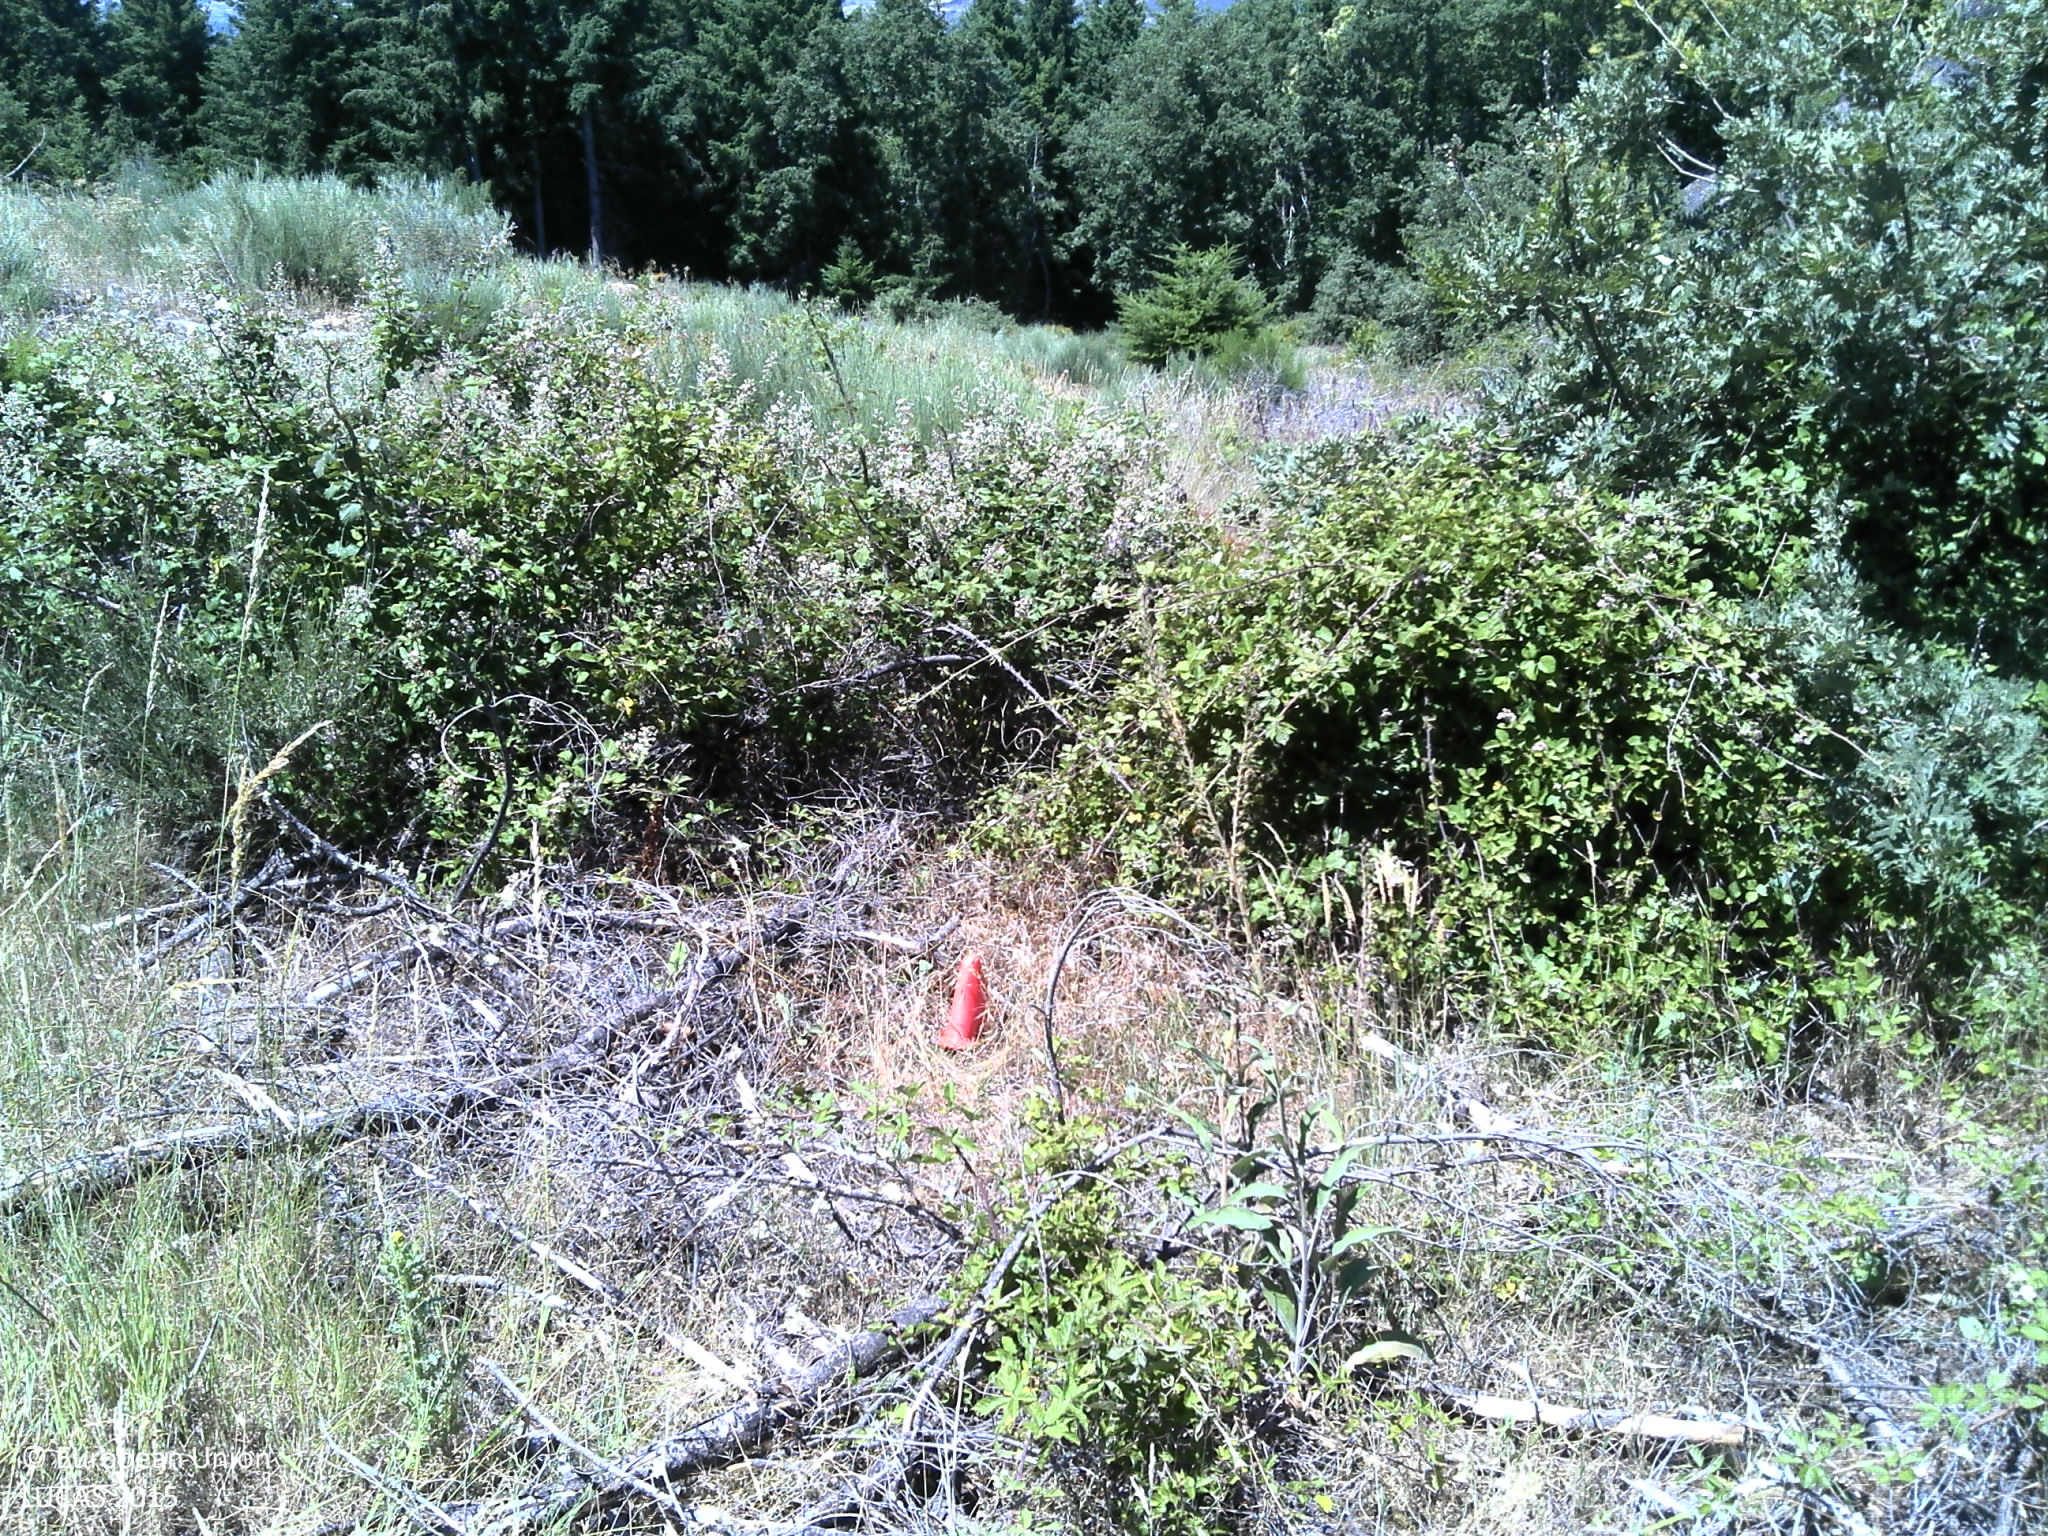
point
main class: Shrubland
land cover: Shrubland with sparse tree cover
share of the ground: > 75 %
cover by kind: shrubs 90 %, coniferous forest trees 5 %, herbaceous plants 5 %
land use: Abandoned areas
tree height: < 5 m
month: June
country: PT
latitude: 41.4652
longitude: -6.9837
